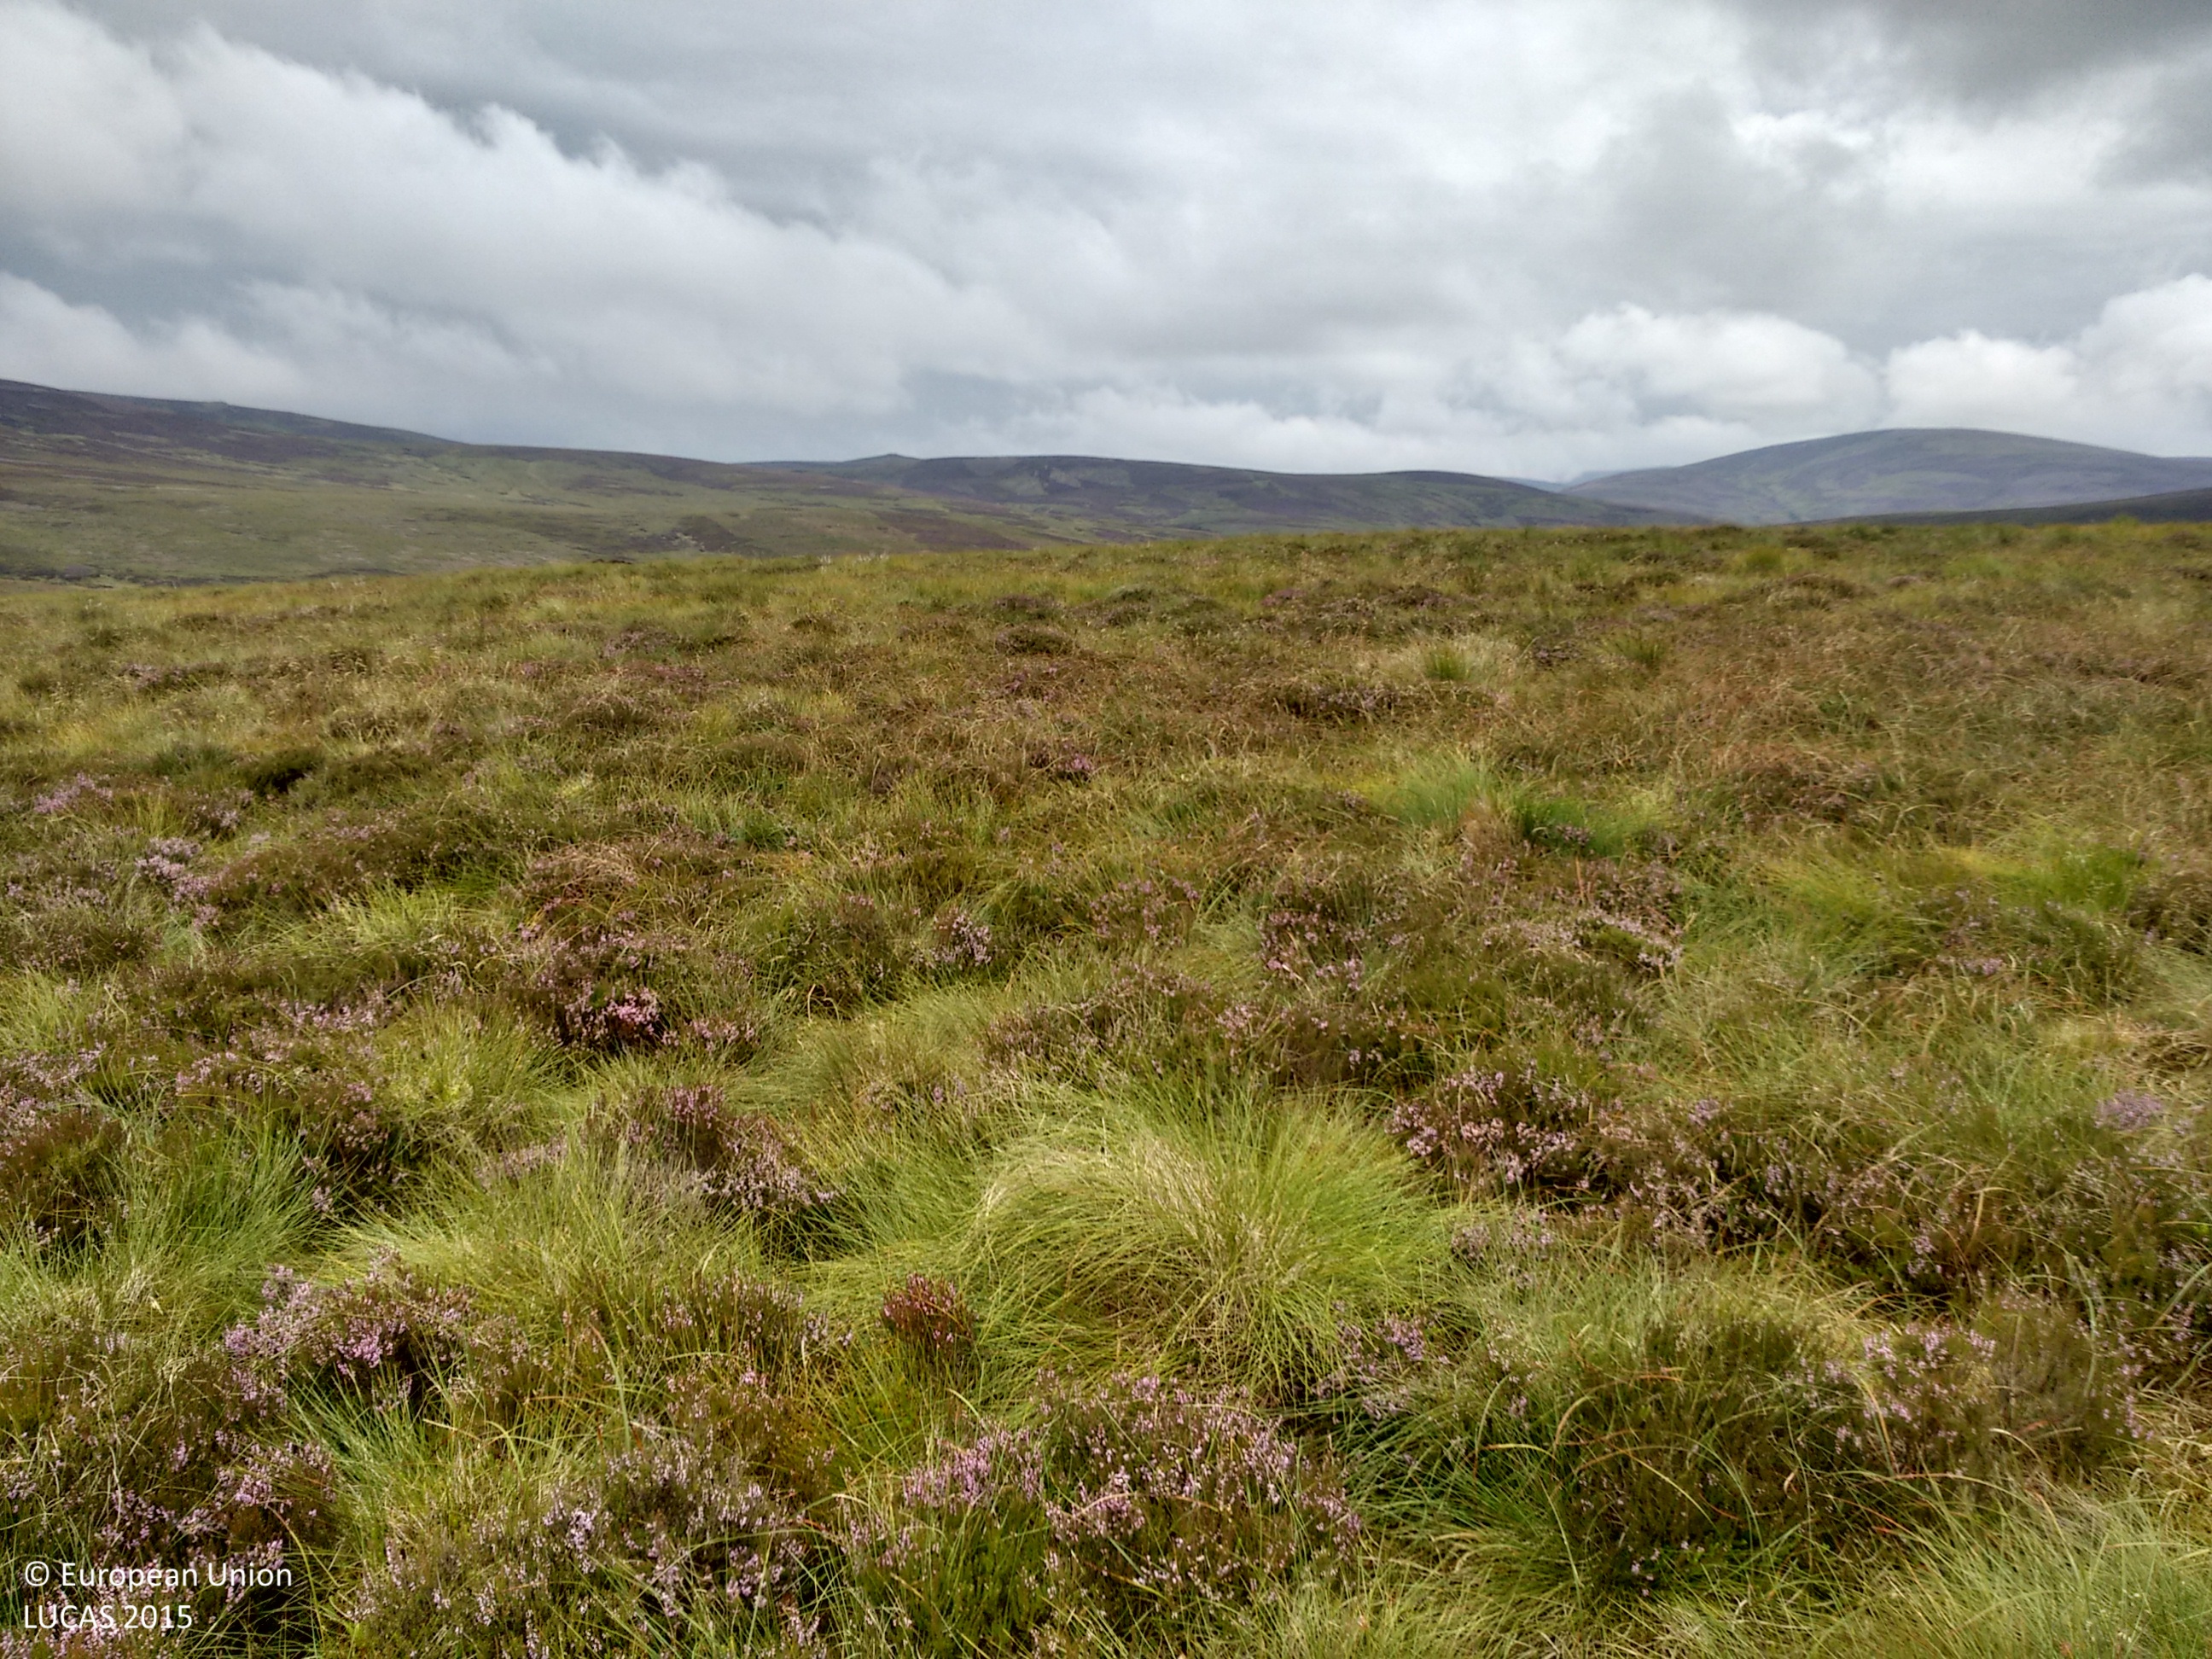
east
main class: Shrubland
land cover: Shrubland without tree cover
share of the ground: > 75 %
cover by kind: shrubs 70 %, herbaceous plants 30 %
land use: Agriculture (excluding fallow land and kitchen gardens)
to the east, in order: Shrubland without tree cover
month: August
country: GB
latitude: 56.9392
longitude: -2.6979
